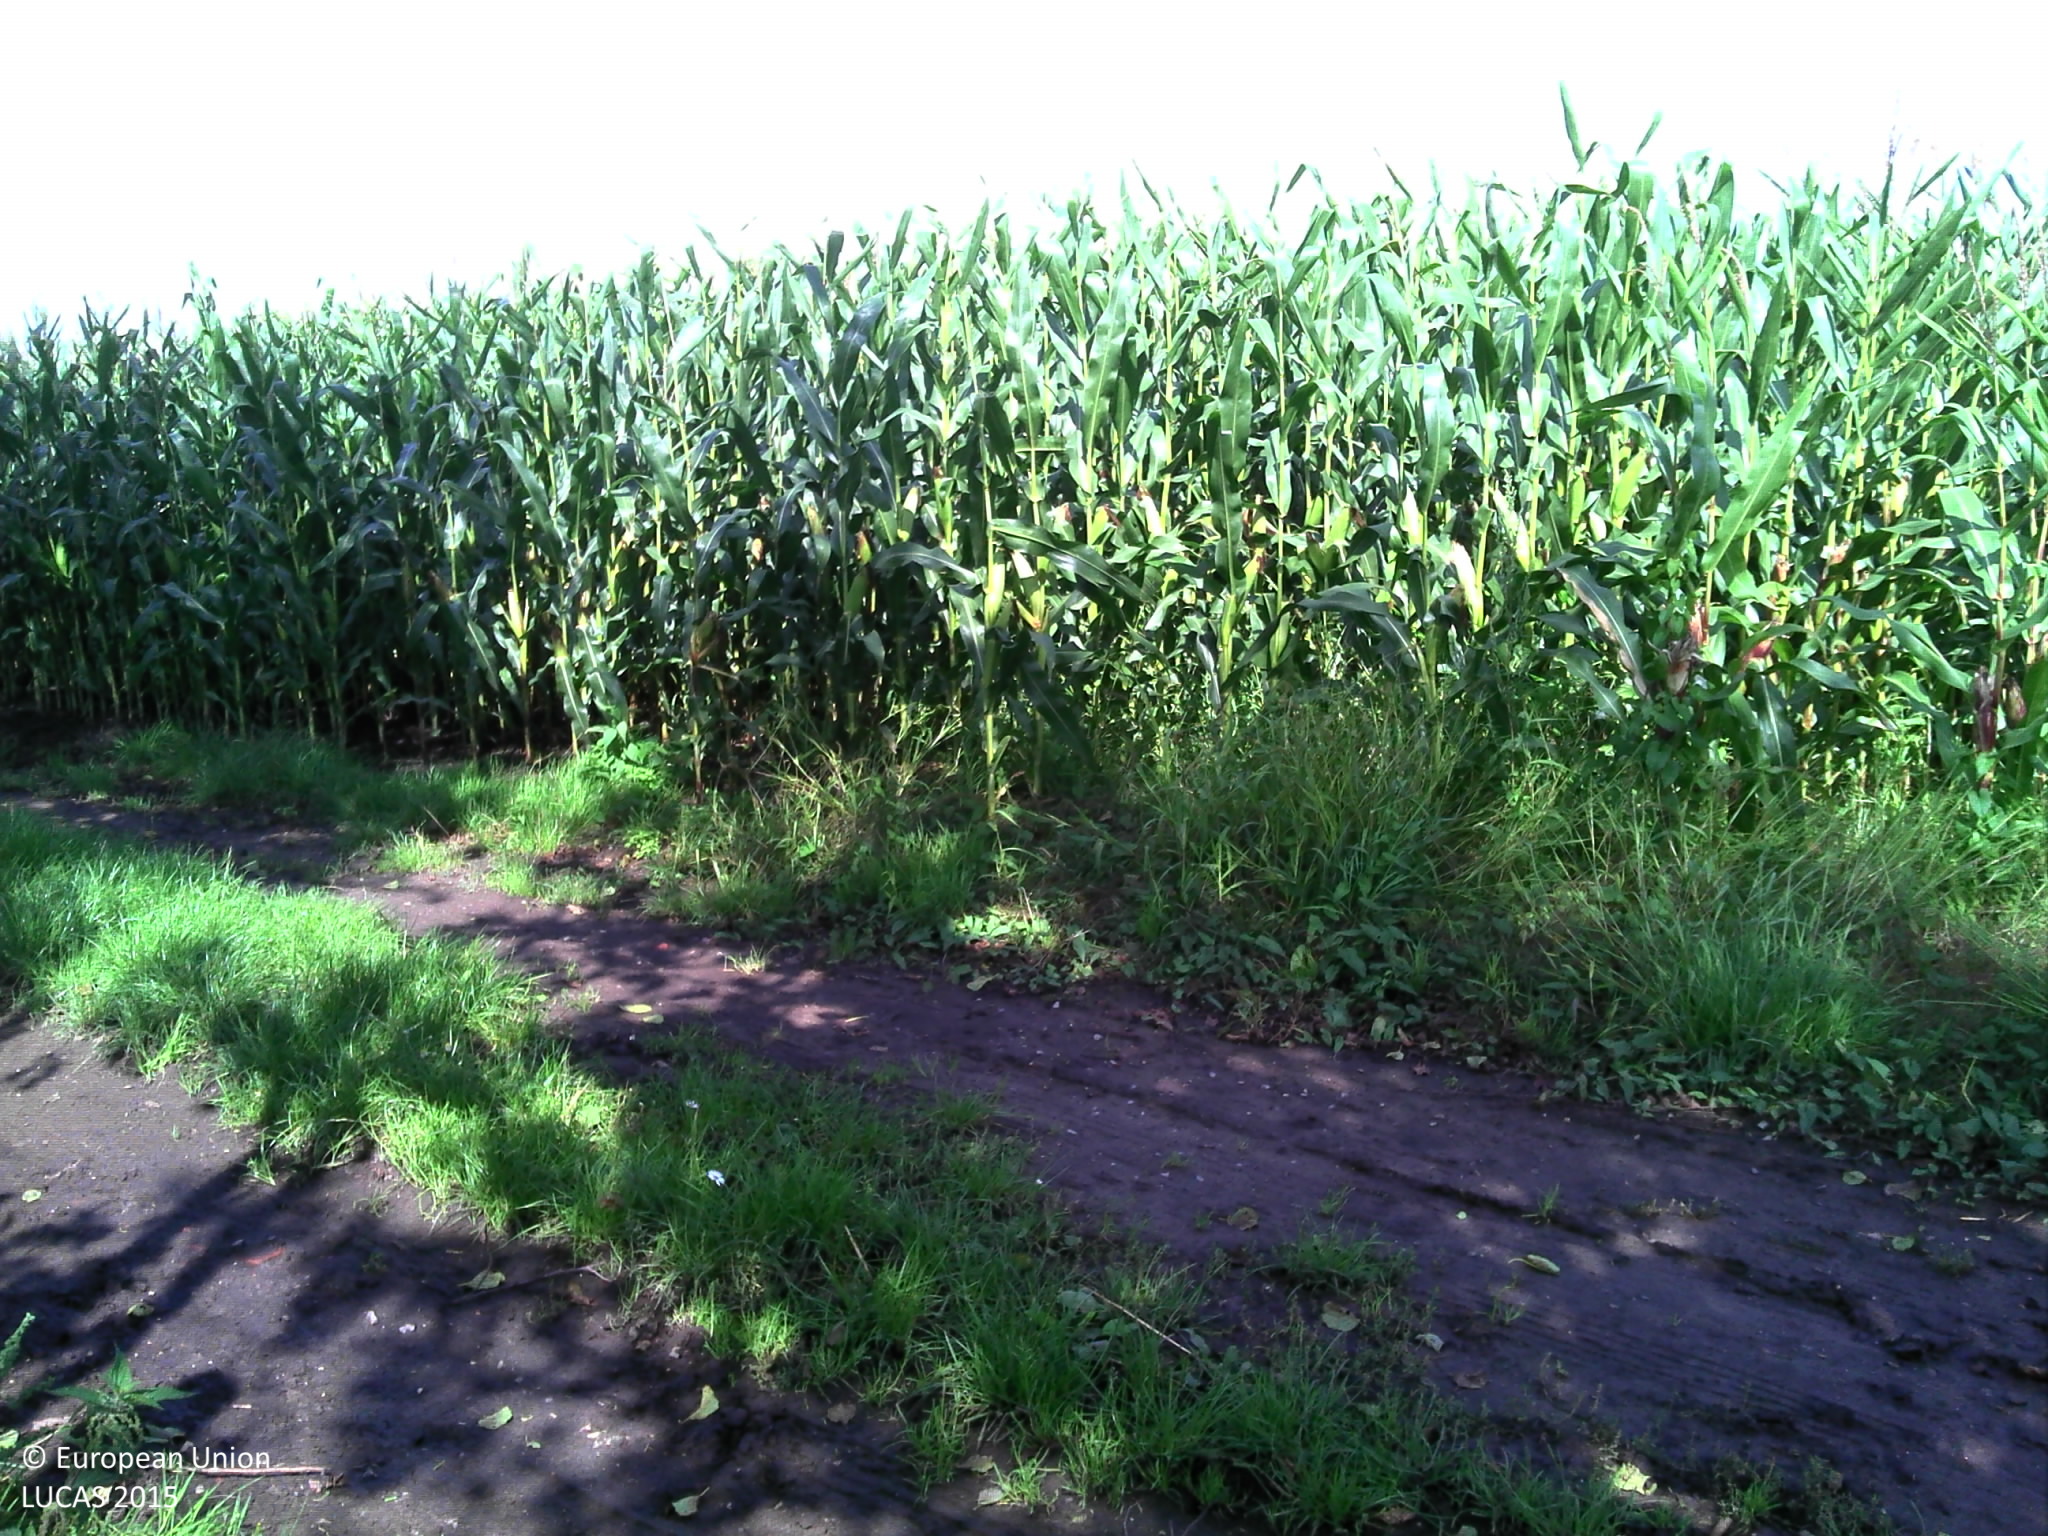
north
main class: Cropland
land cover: Maize
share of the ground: > 75 %
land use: Agriculture (excluding fallow land and kitchen gardens)
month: September
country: BE
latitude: 51.3775
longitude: 4.7237
